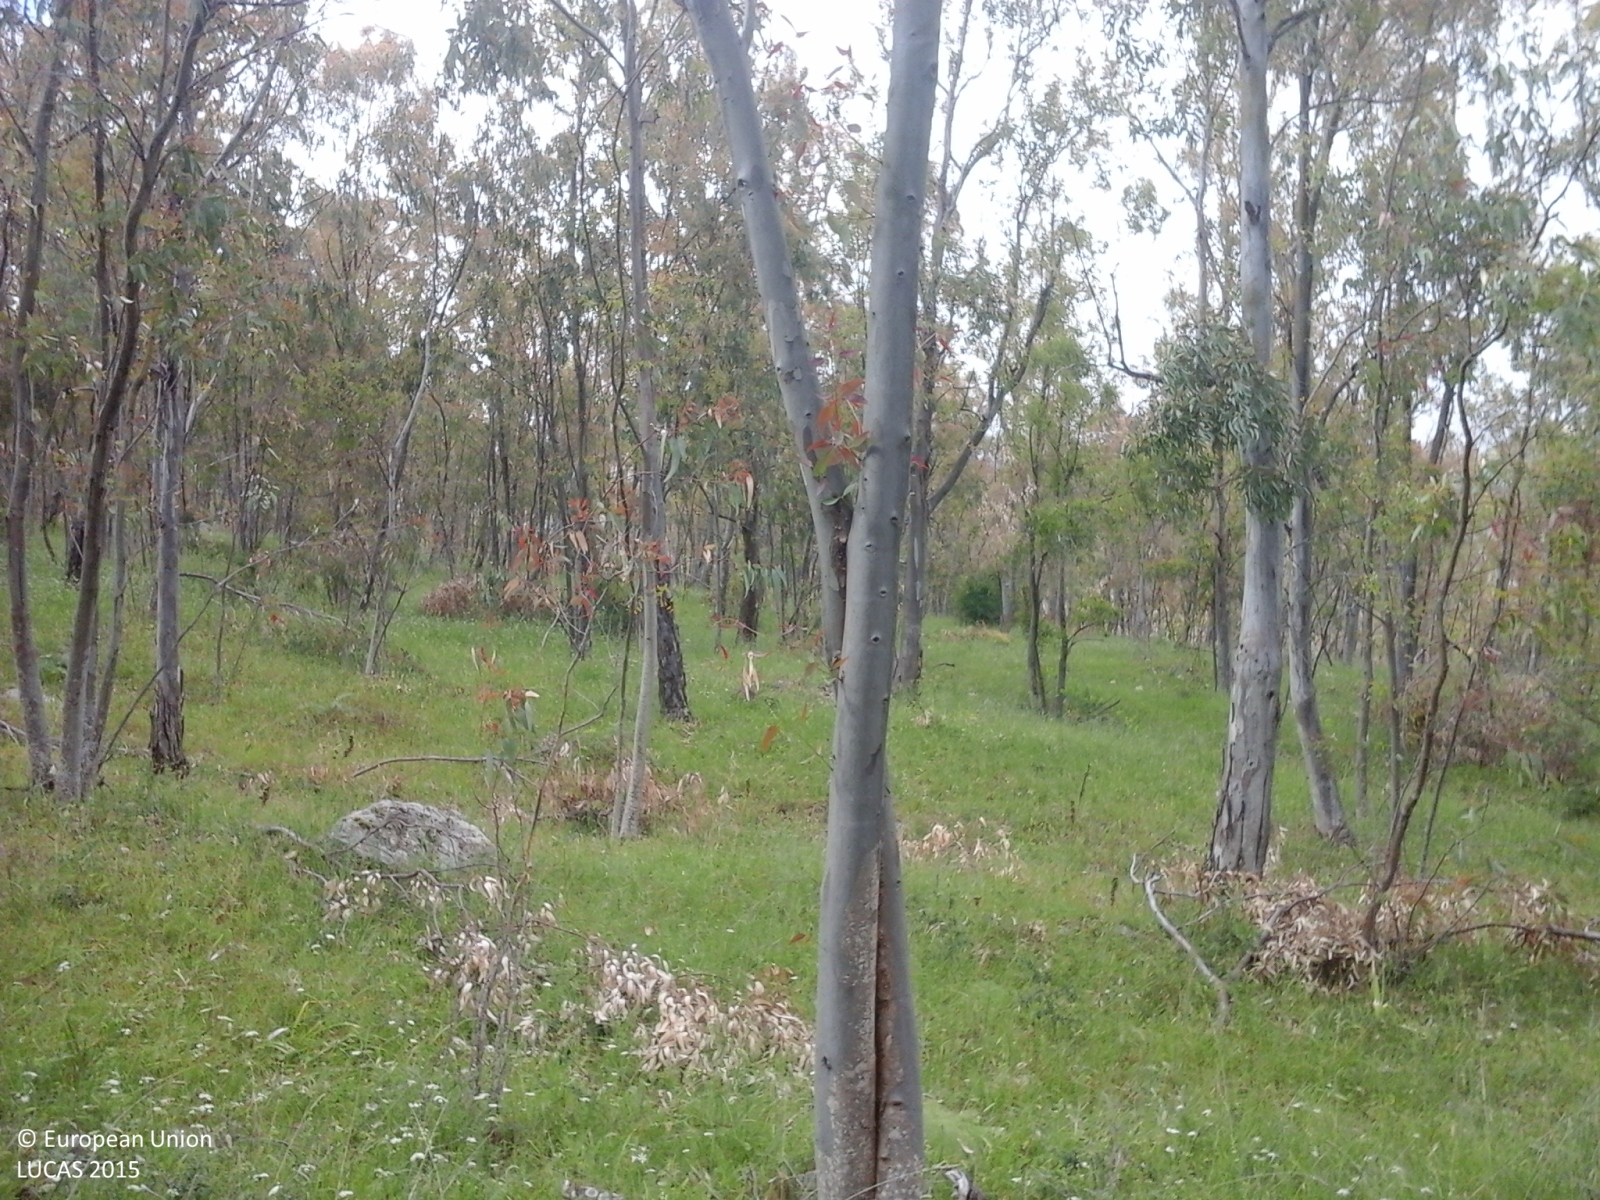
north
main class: Woodland
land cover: Broadleaved woodland
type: broadleaved evergreen forest
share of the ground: > 75 %
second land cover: Grassland without tree/shrub cover
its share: > 75 %
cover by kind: broadleaved forest trees 80 %, herbaceous plants 10 %, shrubs 5 %, consolidated bare surface 5 %
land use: Forestry
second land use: Agriculture (excluding fallow land and kitchen gardens)
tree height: > 5 m
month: May
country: IT
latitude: 37.8259
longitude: 14.4338
